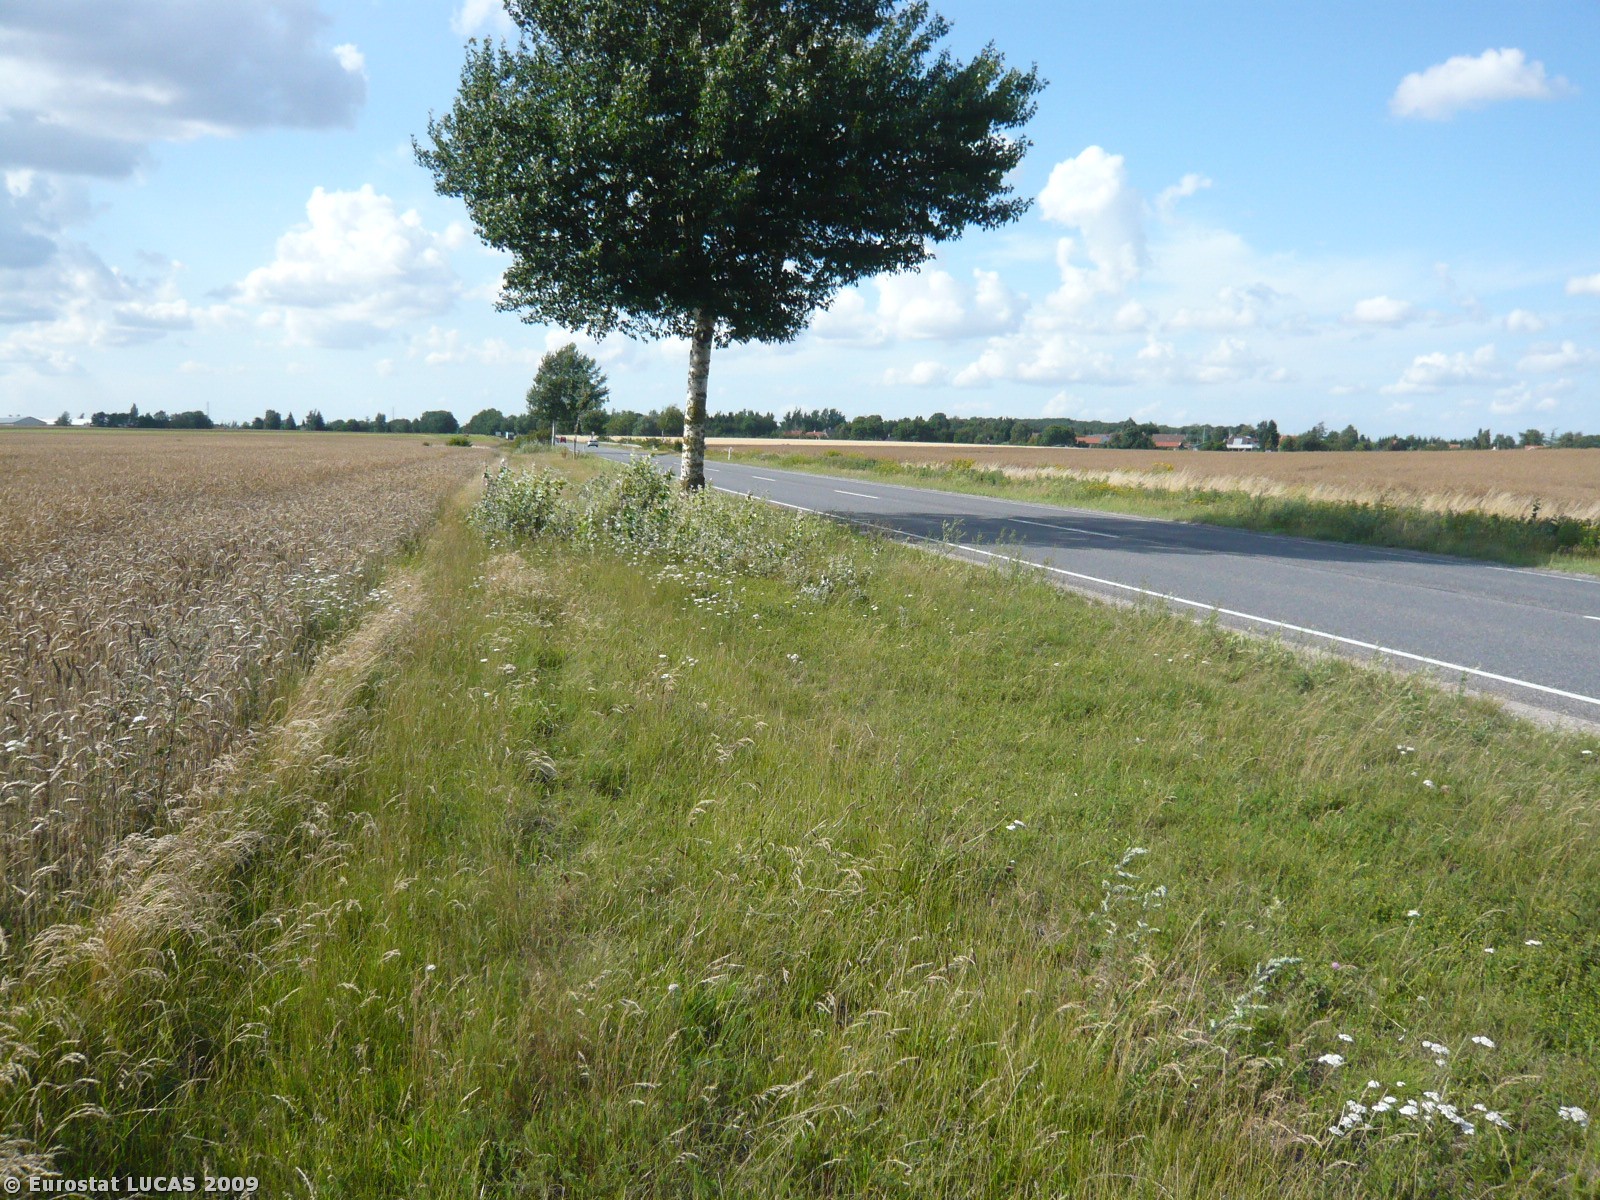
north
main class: Cropland
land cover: Common wheat
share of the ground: > 75 %
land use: Agriculture (excluding fallow land and kitchen gardens)
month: July
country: DK
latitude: 55.5929
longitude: 12.2356
